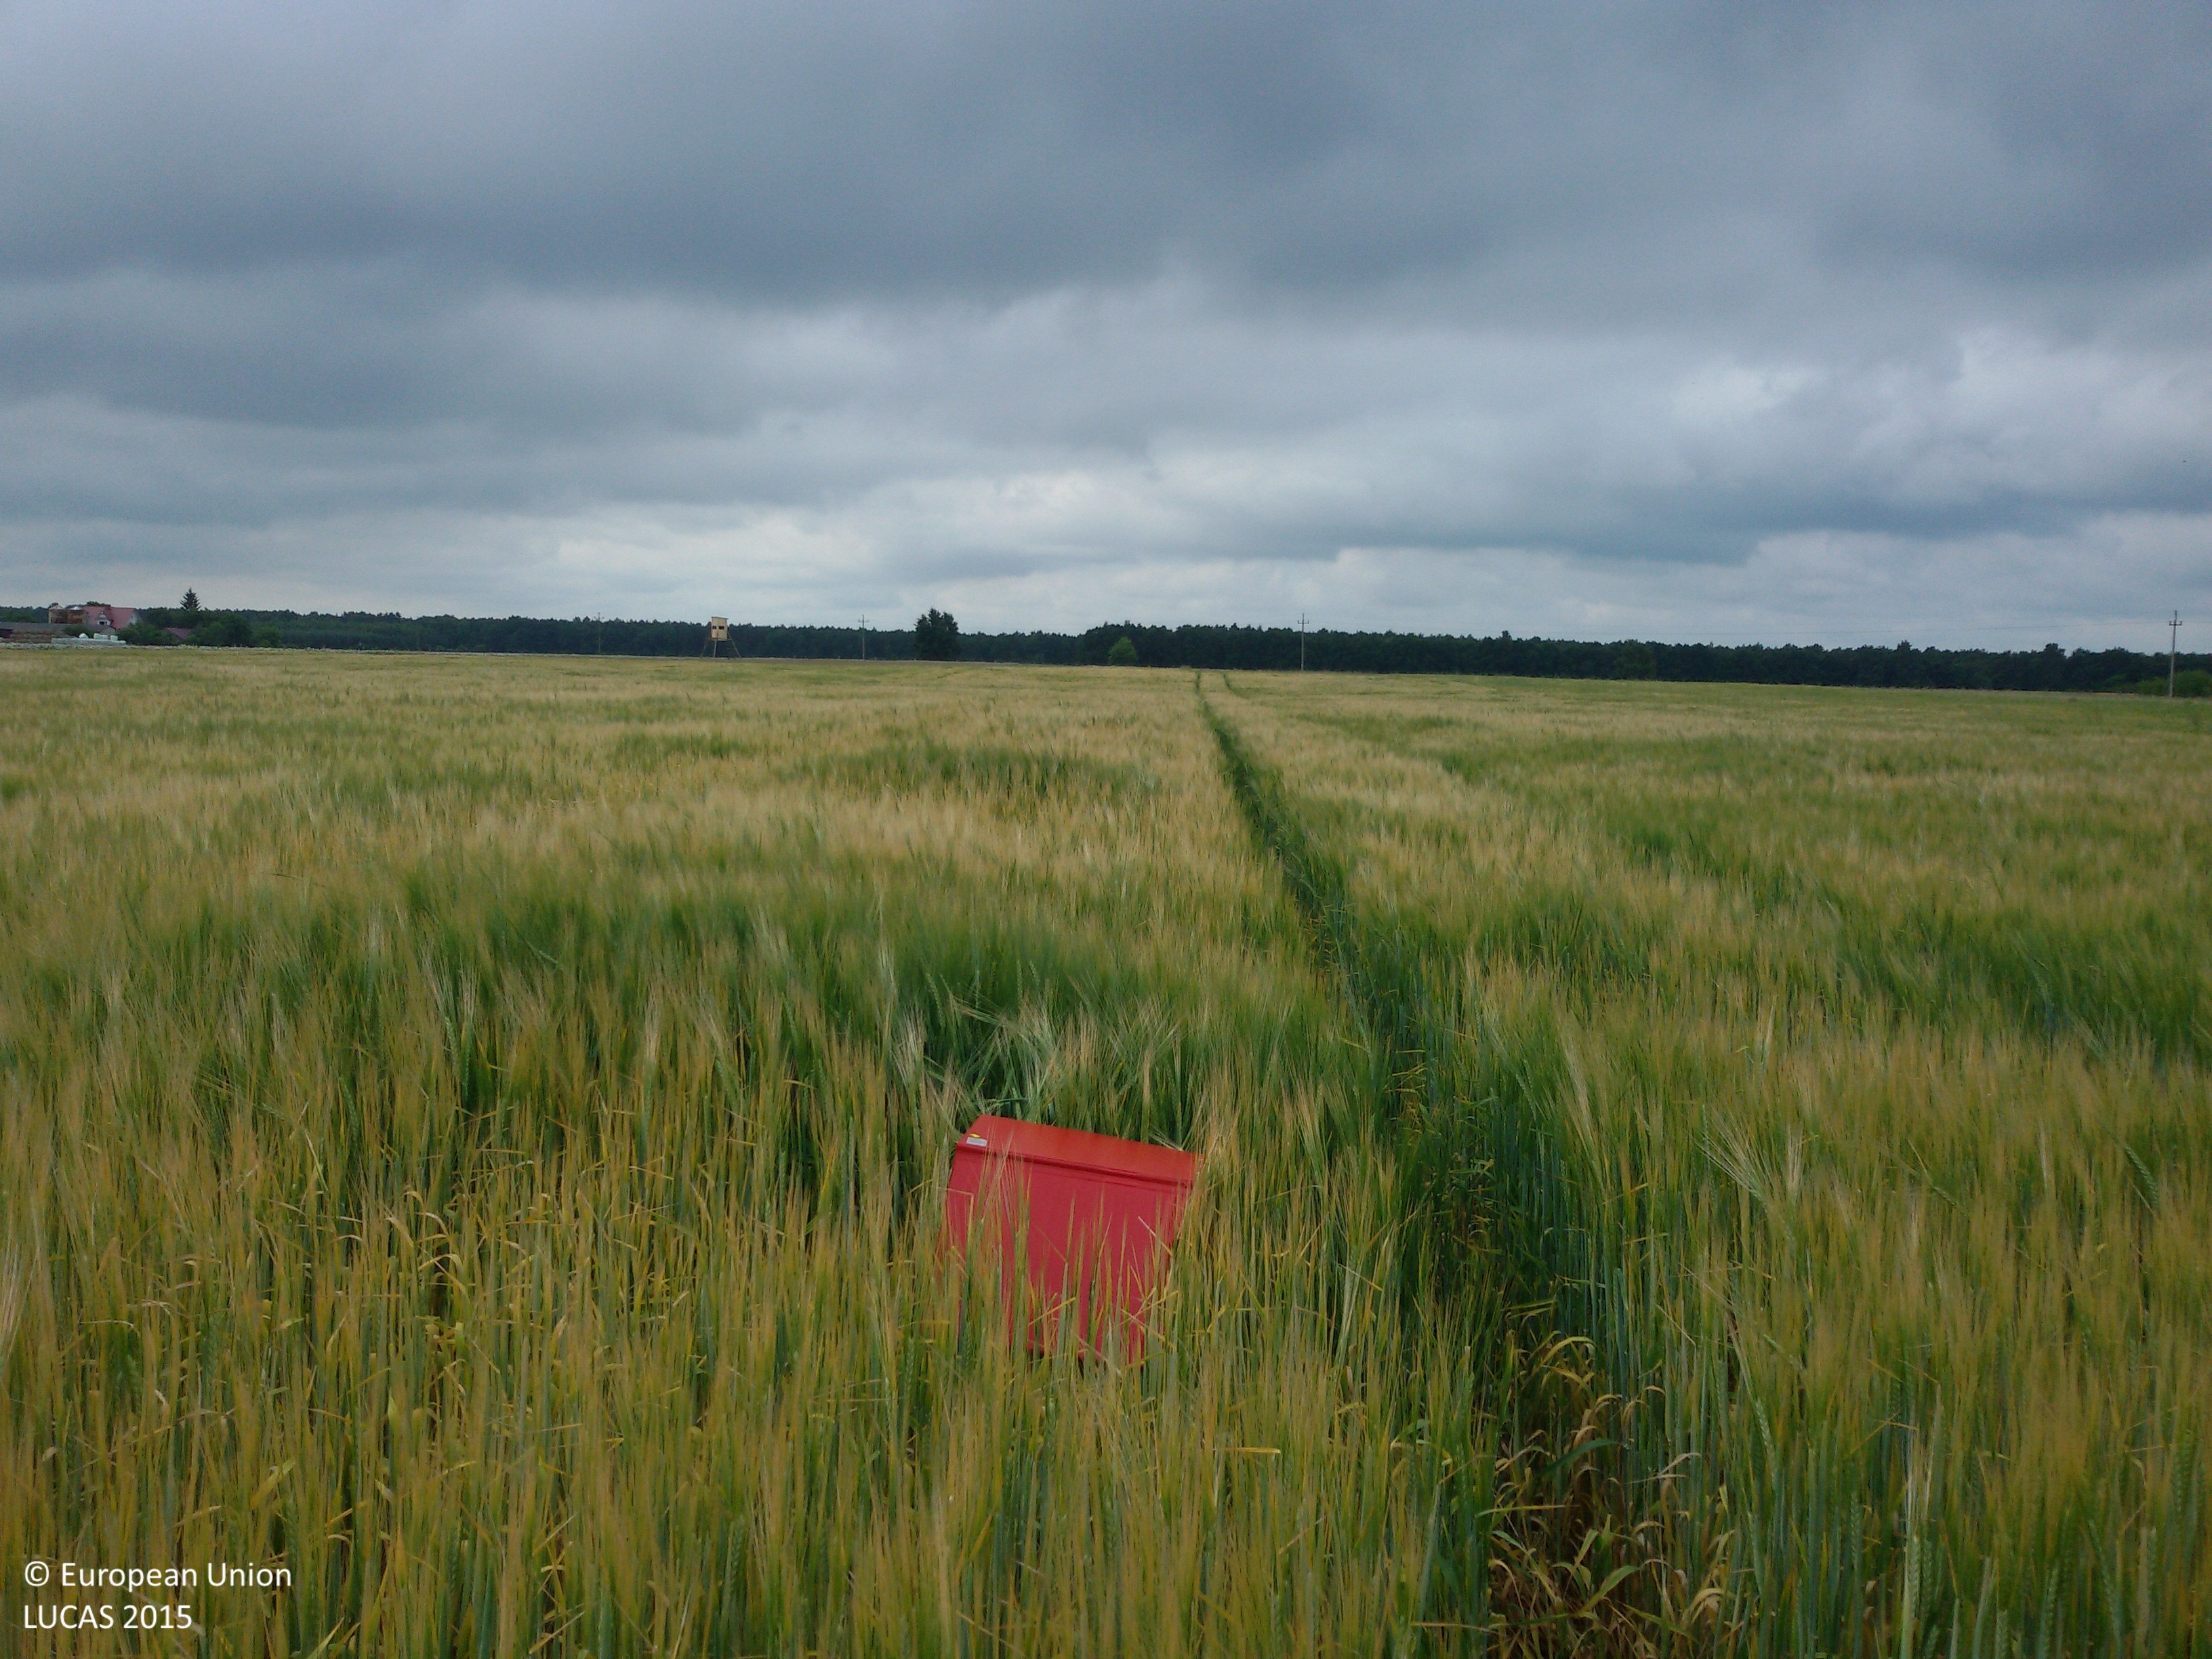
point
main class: Cropland
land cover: Barley
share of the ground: > 75 %
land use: Agriculture (excluding fallow land and kitchen gardens)
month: June
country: PL
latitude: 51.3749
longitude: 22.9315
